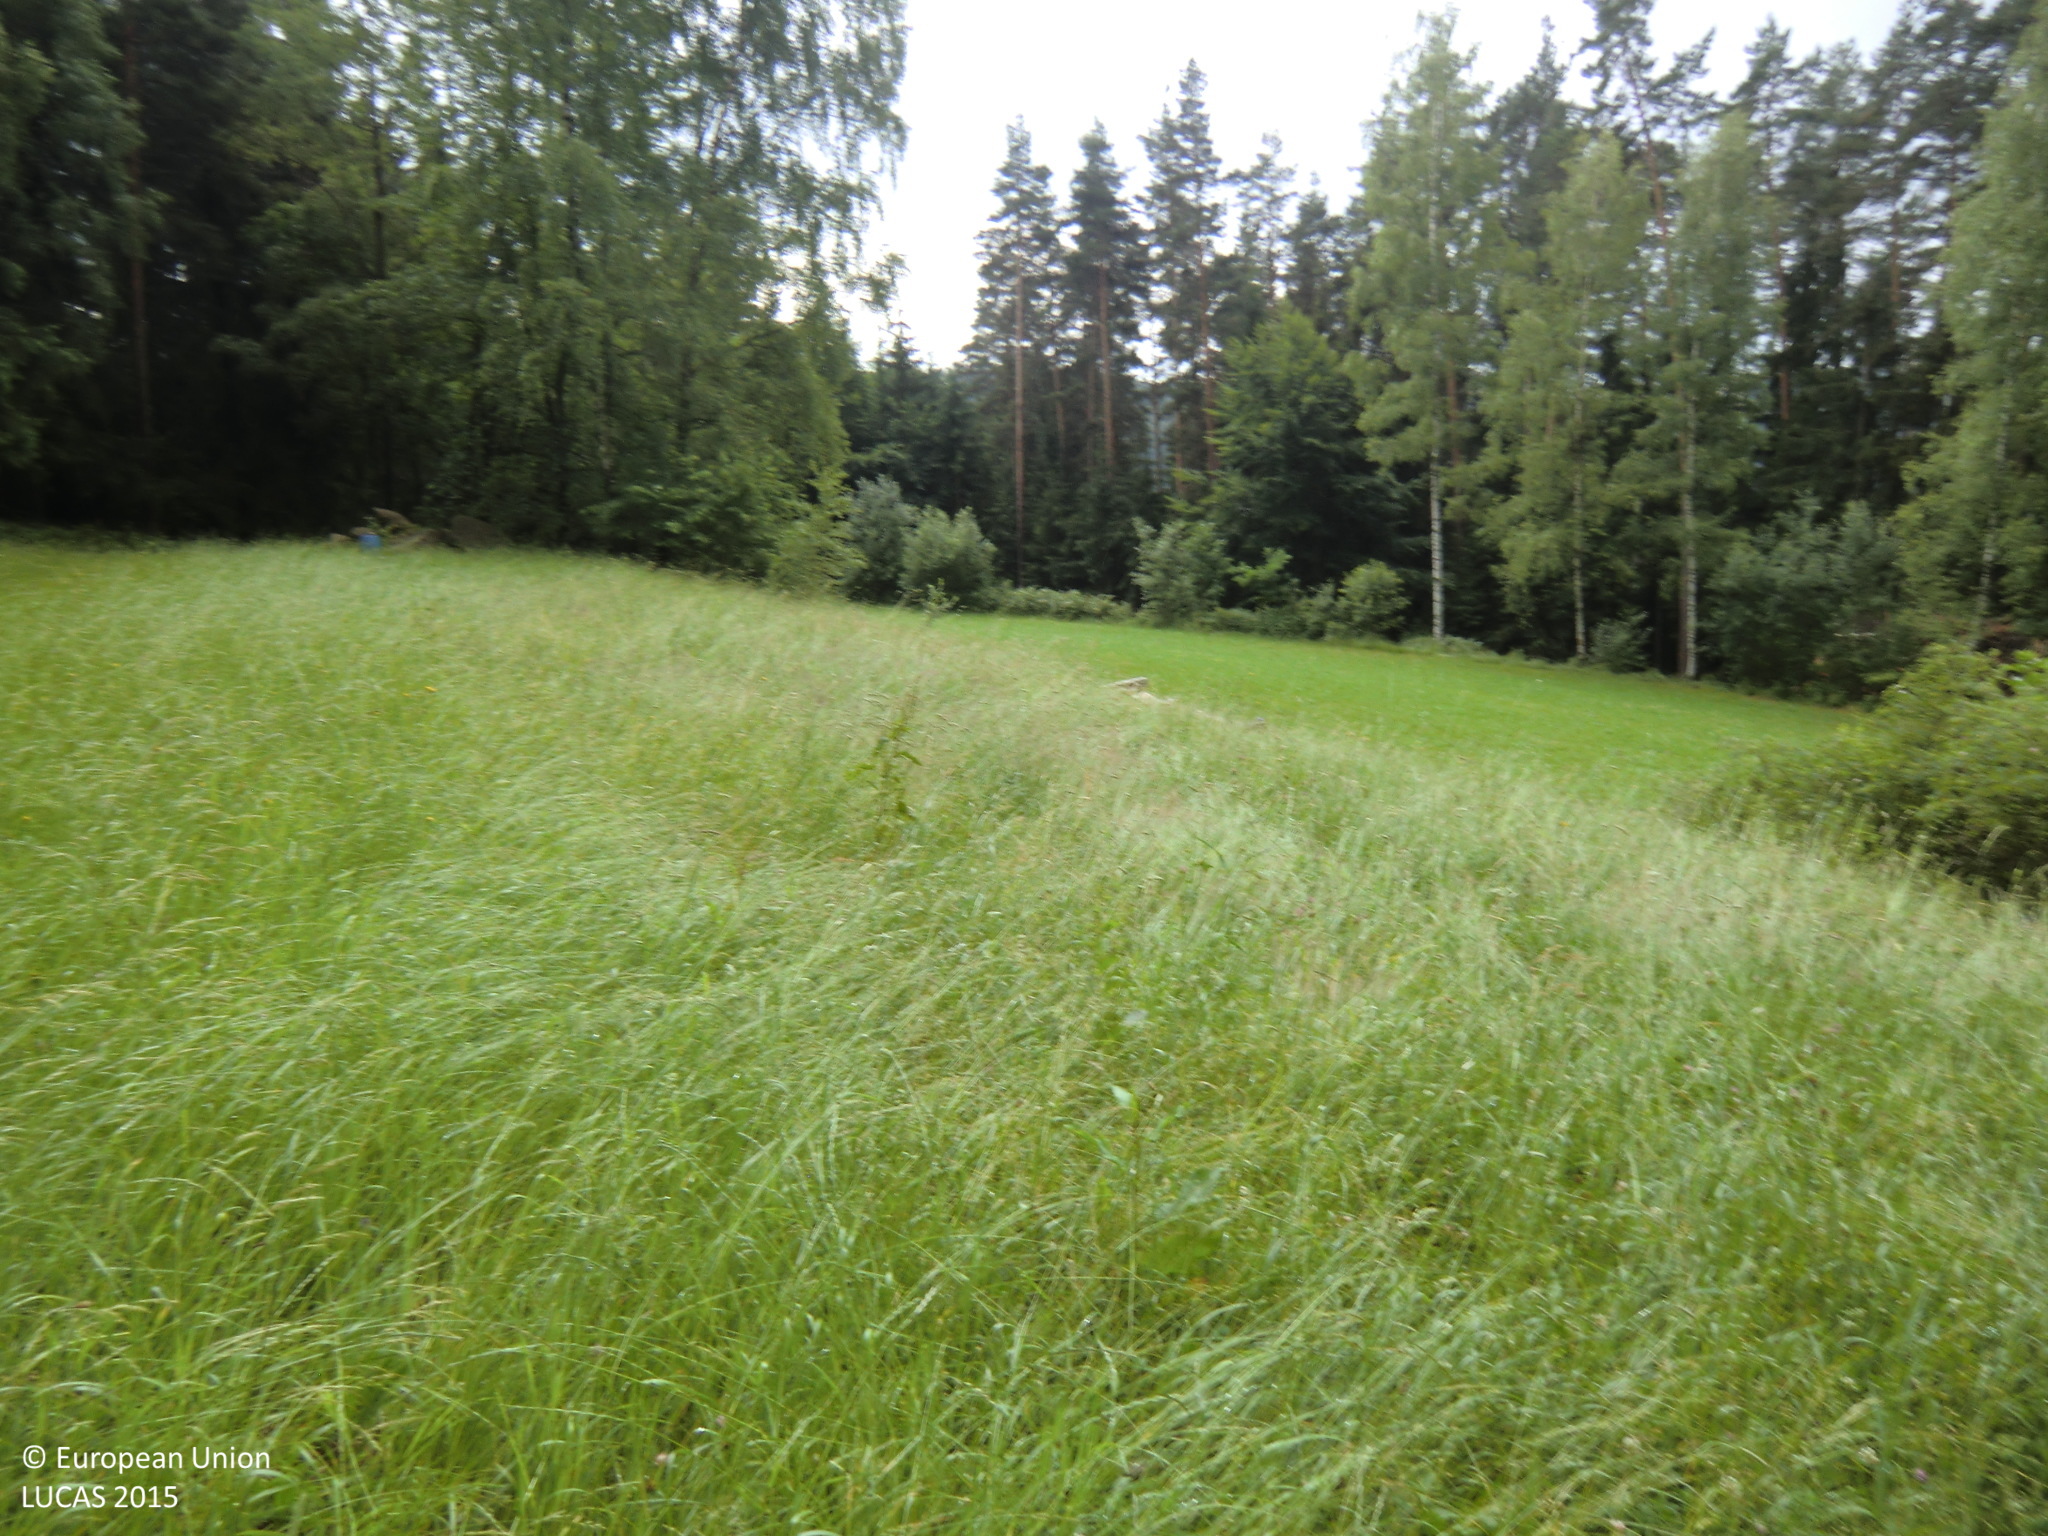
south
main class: Grassland
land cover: Grassland without tree/shrub cover
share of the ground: > 75 %
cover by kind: herbaceous plants 90 %, unconsolidated bare surface 10 %
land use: Agriculture (excluding fallow land and kitchen gardens)
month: June
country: AT
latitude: 48.5076
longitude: 14.5623
